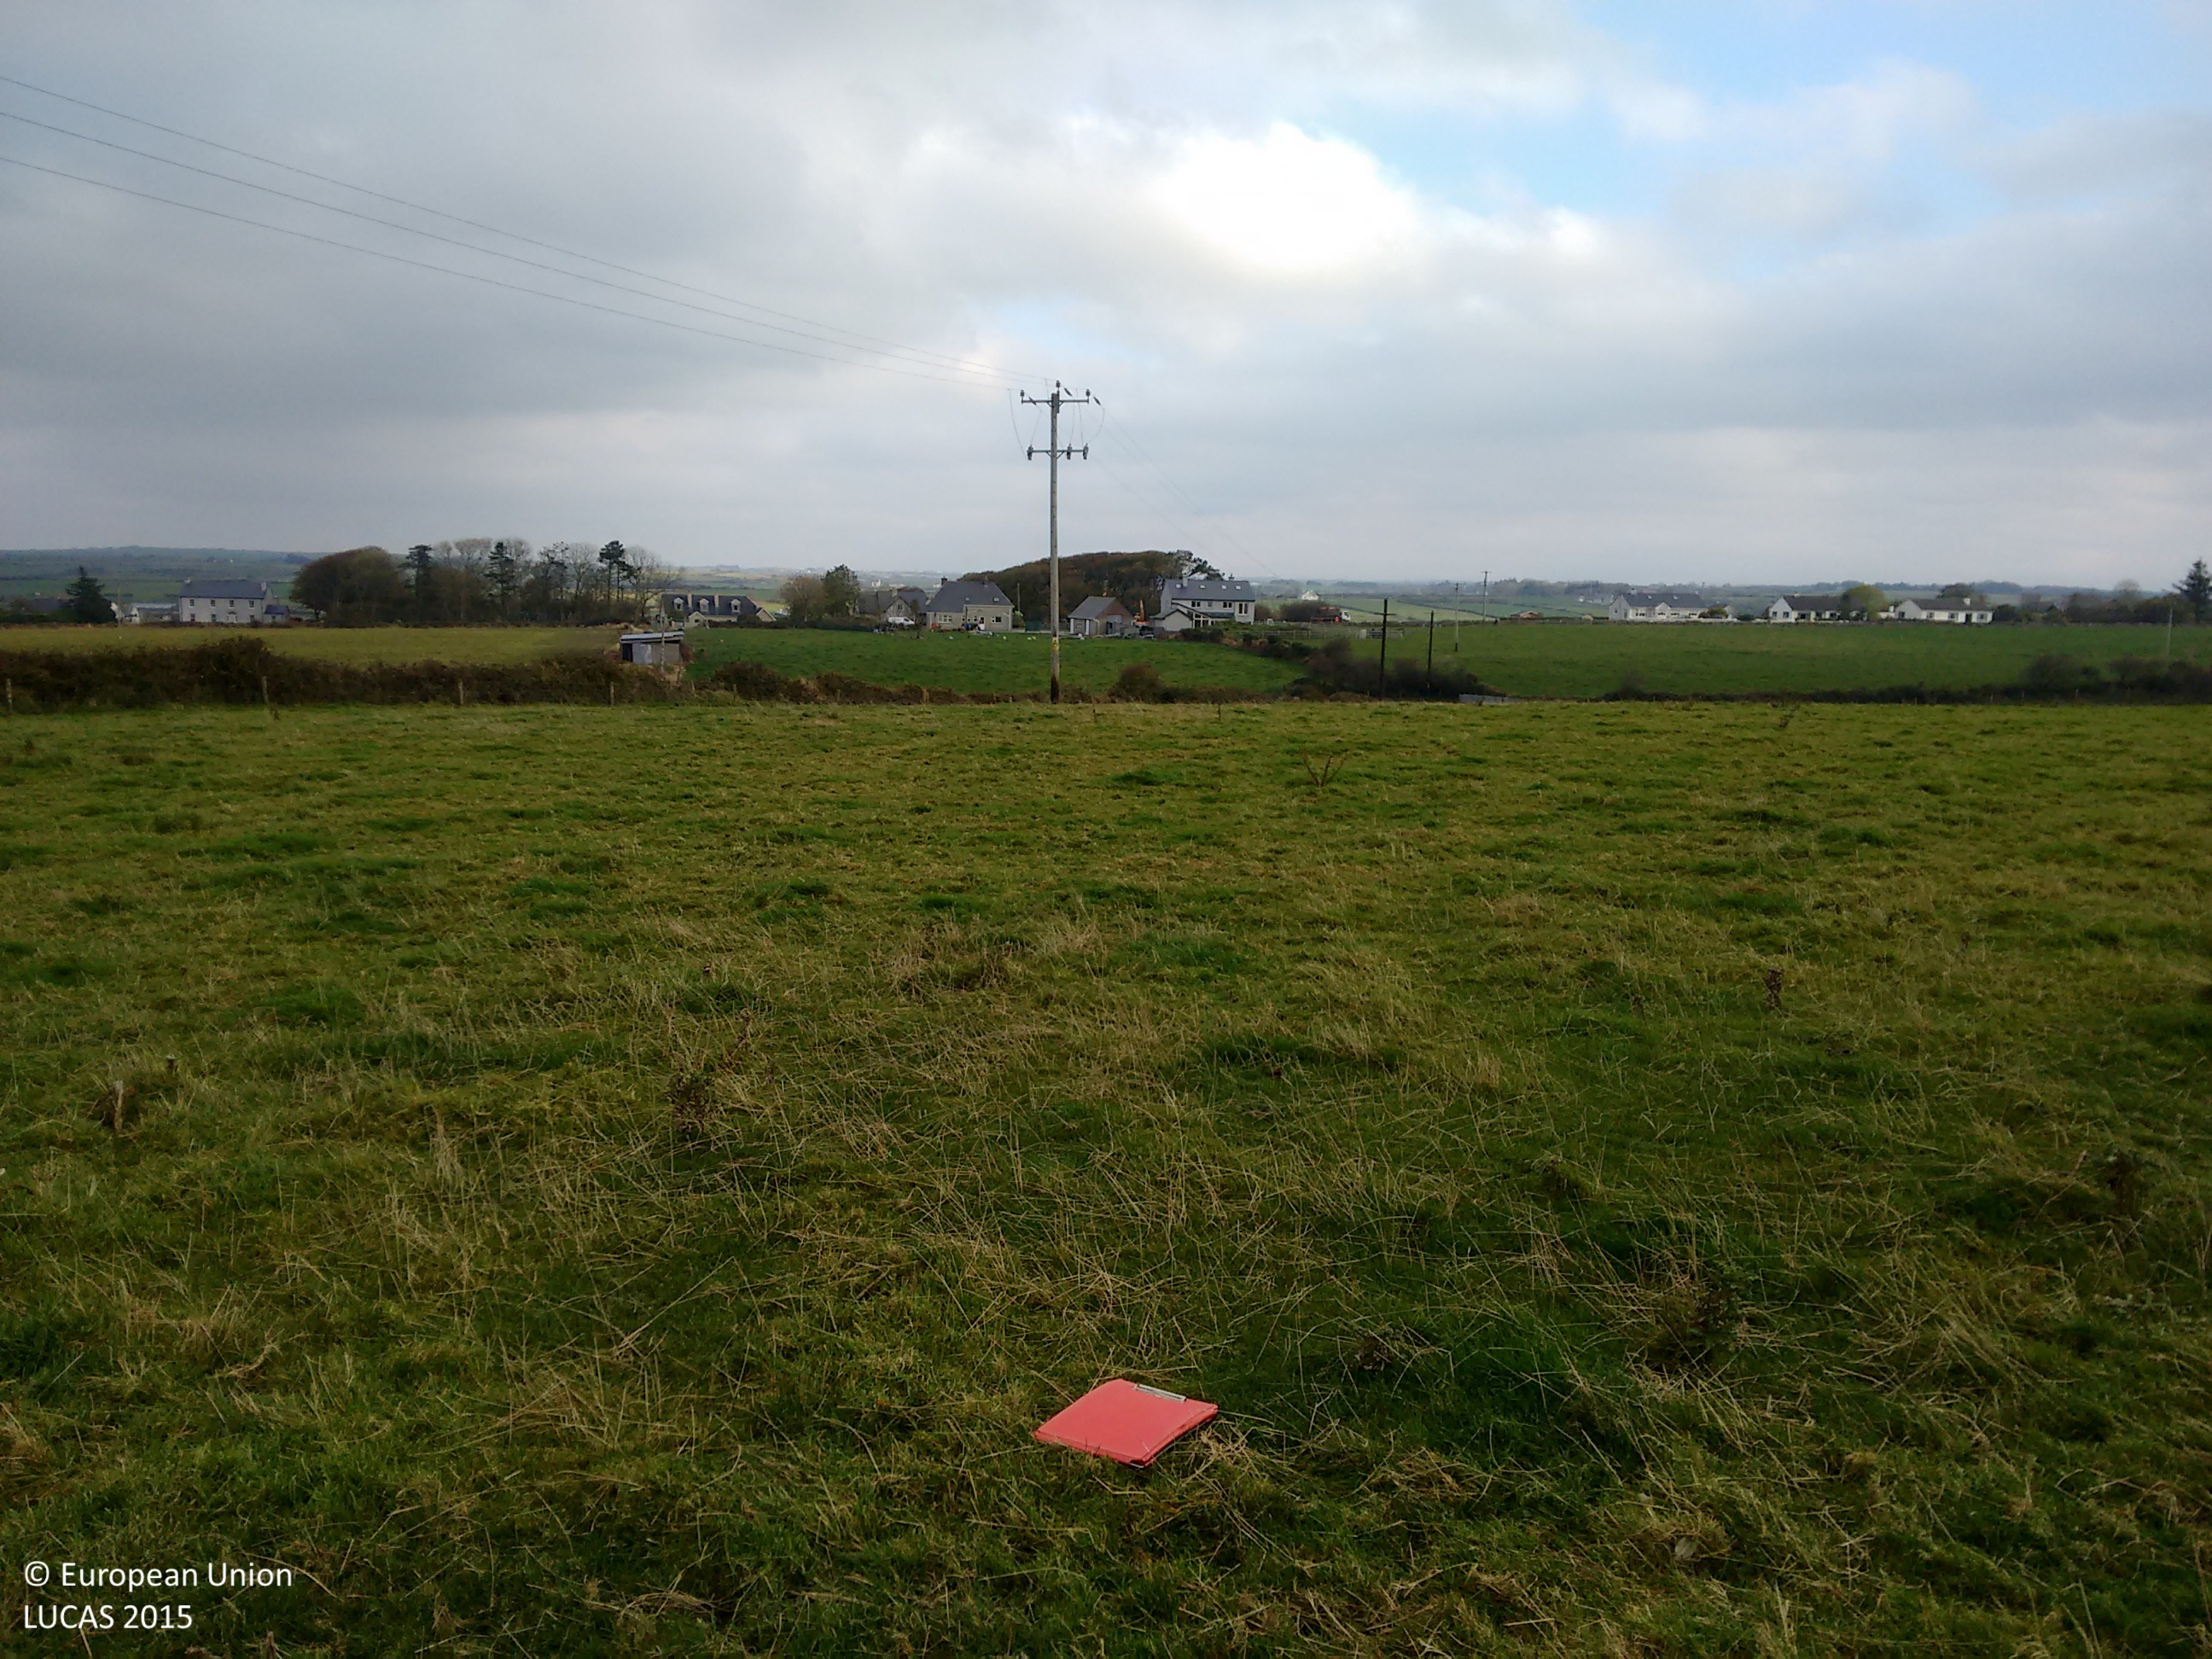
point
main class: Grassland
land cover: Grassland without tree/shrub cover
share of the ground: > 75 %
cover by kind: herbaceous plants 100 %
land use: Agriculture (excluding fallow land and kitchen gardens)
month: November
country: IE
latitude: 54.1916
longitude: -9.1127
